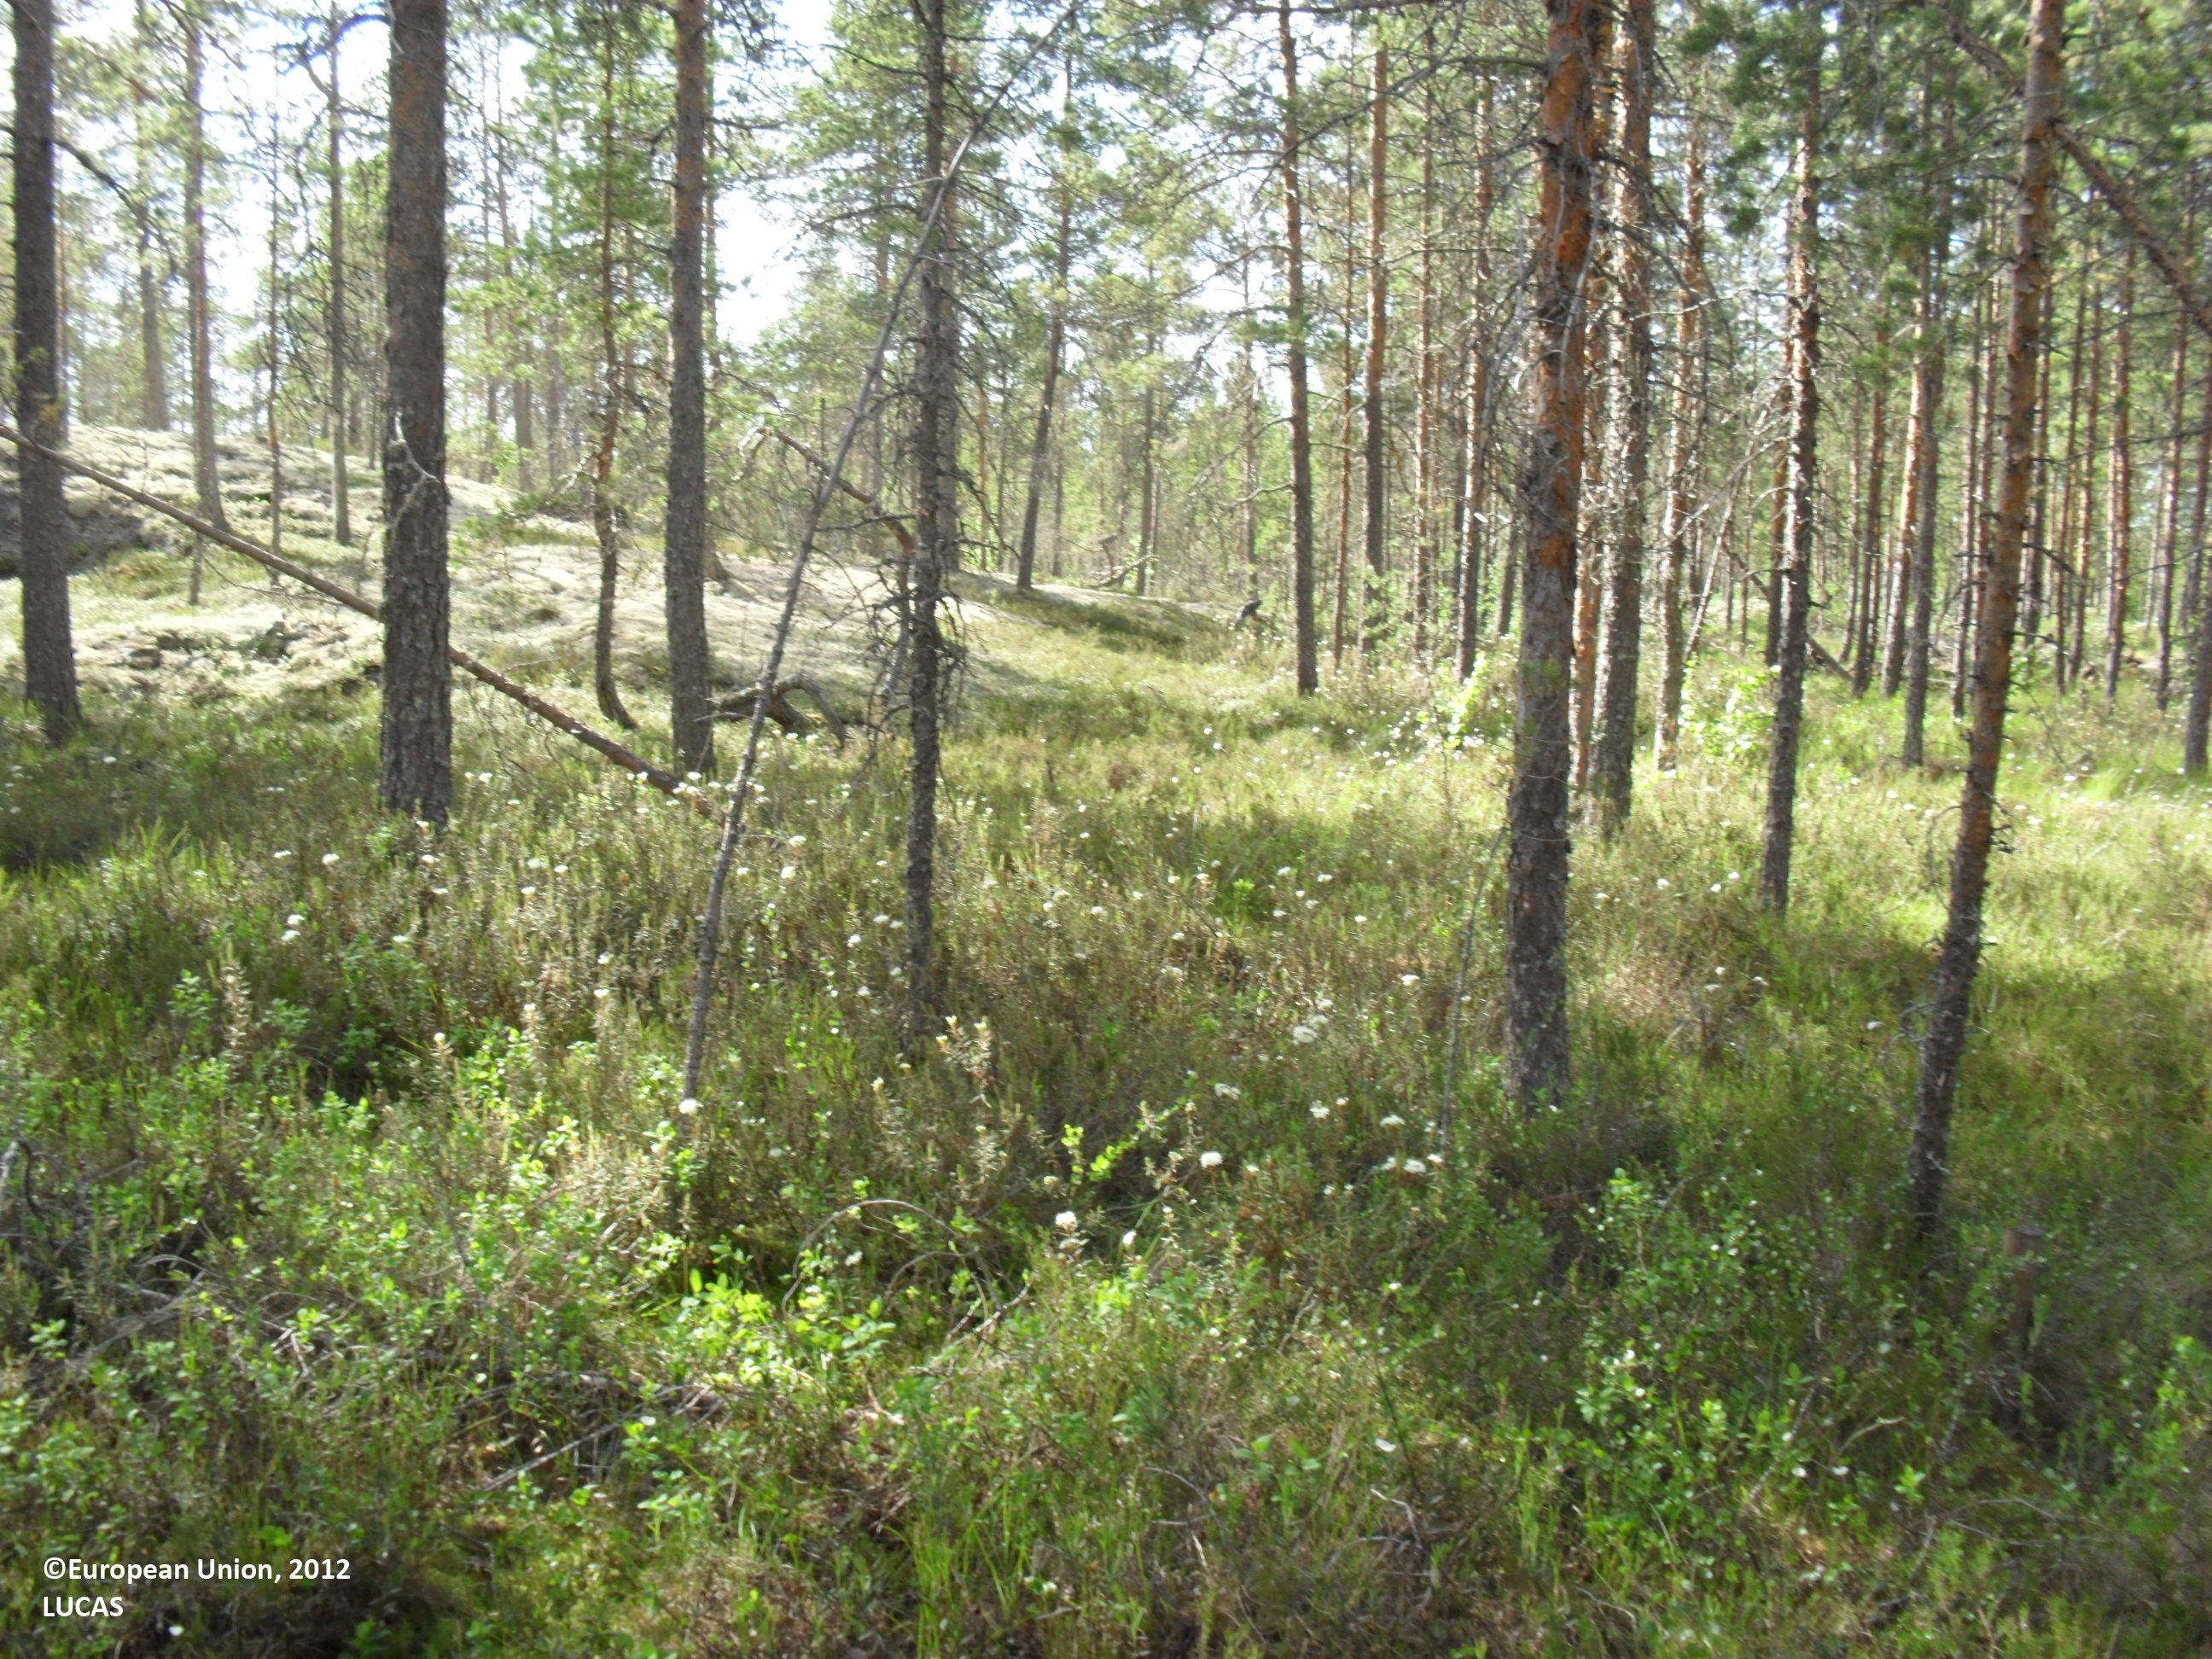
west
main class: Woodland
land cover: Pine dominated coniferous woodland
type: mire and swamp forests
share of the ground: 25 - 50 %
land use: Forestry
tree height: > 5 m
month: June
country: FI
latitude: 62.9237
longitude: 23.4374
